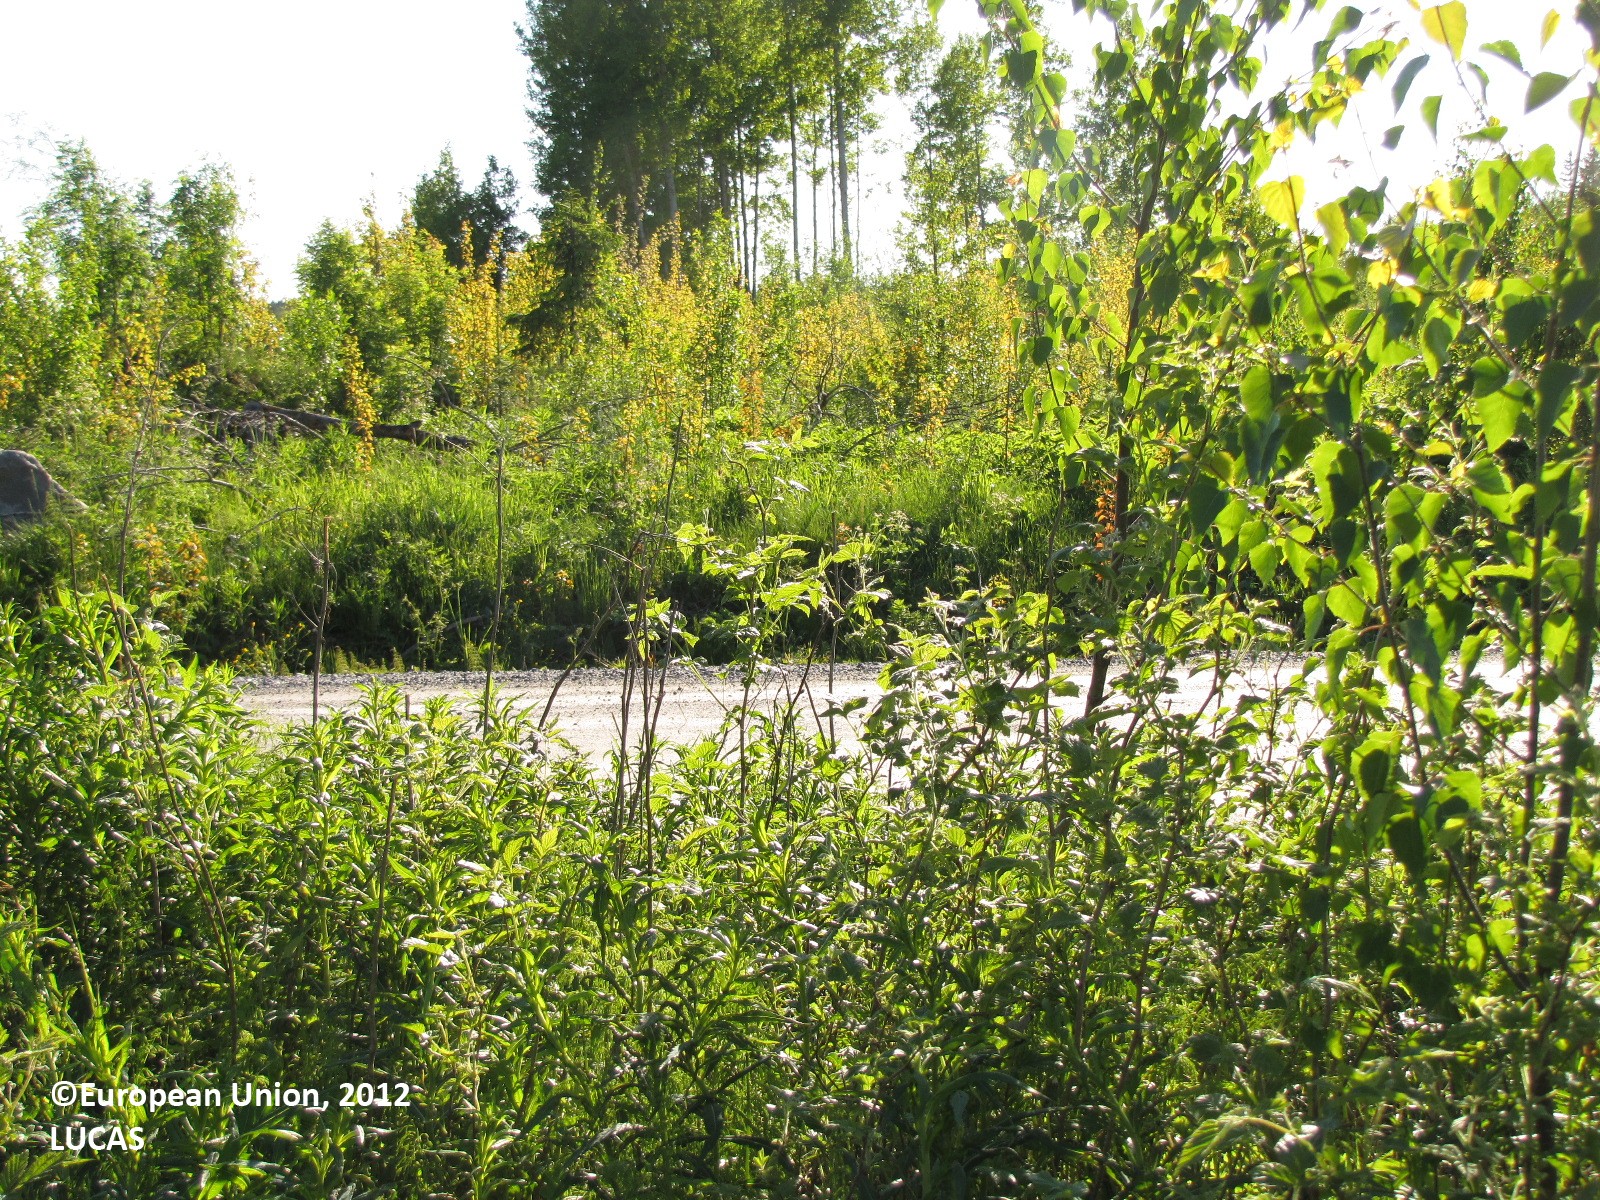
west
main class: Woodland
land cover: Broadleaved woodland
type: boreal forest
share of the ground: 25 - 50 %
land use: Forestry
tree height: < 5 m
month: June
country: FI
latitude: 61.3926
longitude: 22.9330
